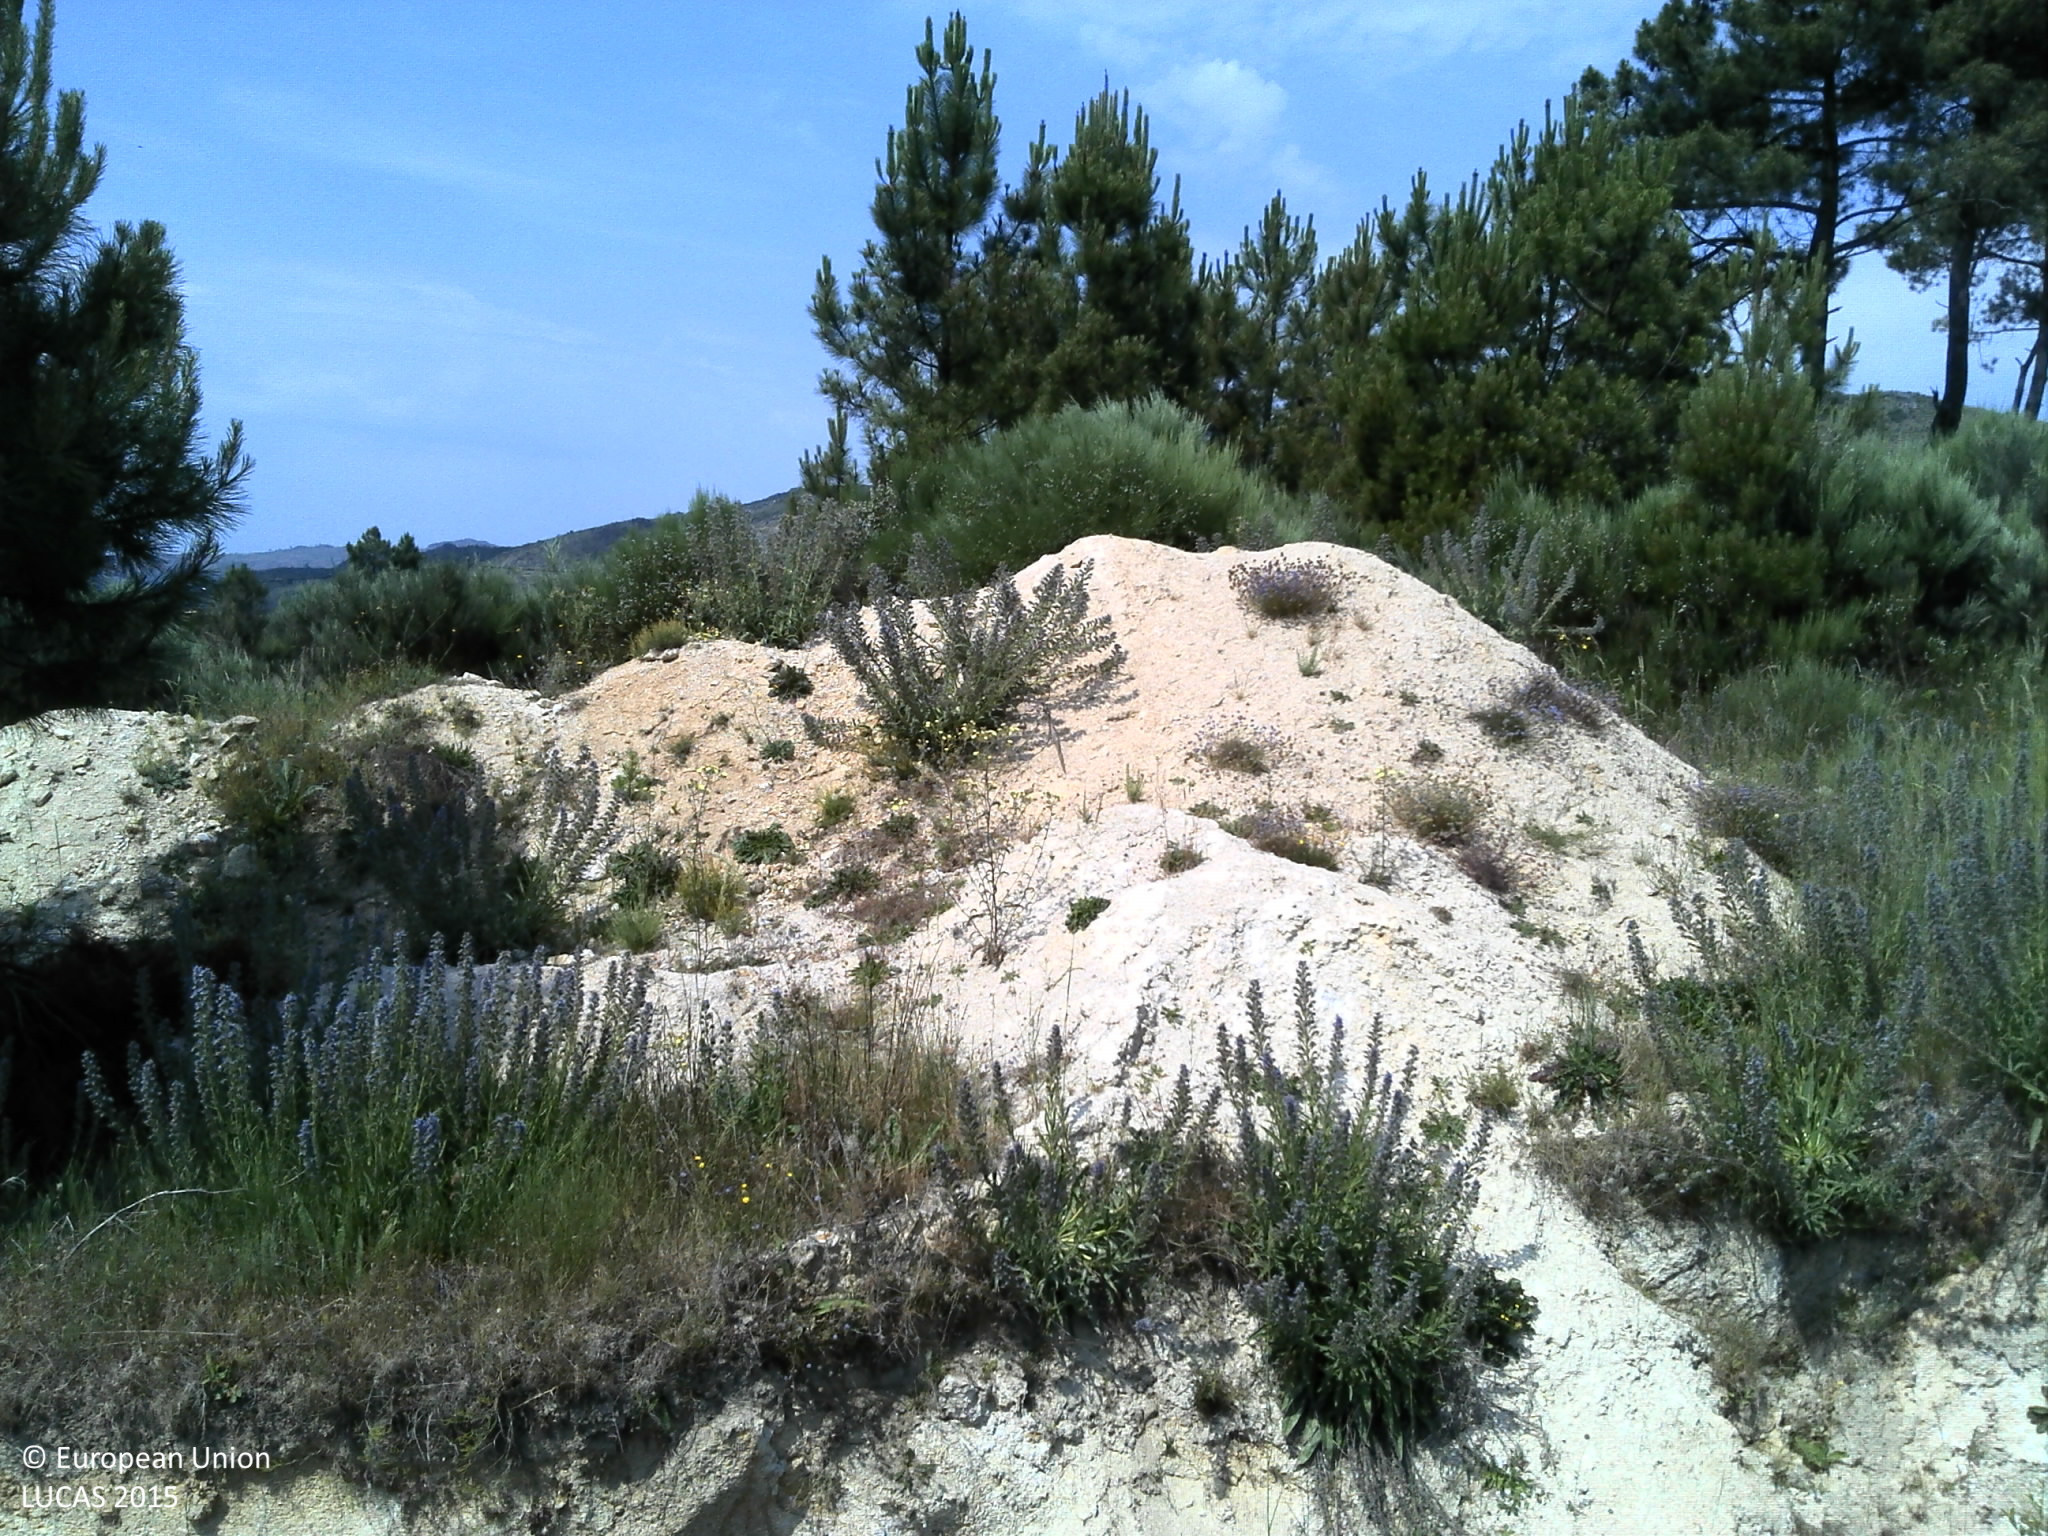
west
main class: Shrubland
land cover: Shrubland with sparse tree cover
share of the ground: 50 - 75 %
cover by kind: shrubs 70 %, unconsolidated bare surface 25 %, coniferous forest trees 5 %
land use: Semi-natural and natural areas not in use
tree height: > 5 m
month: June
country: PT
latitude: 41.4192
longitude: -7.5600
